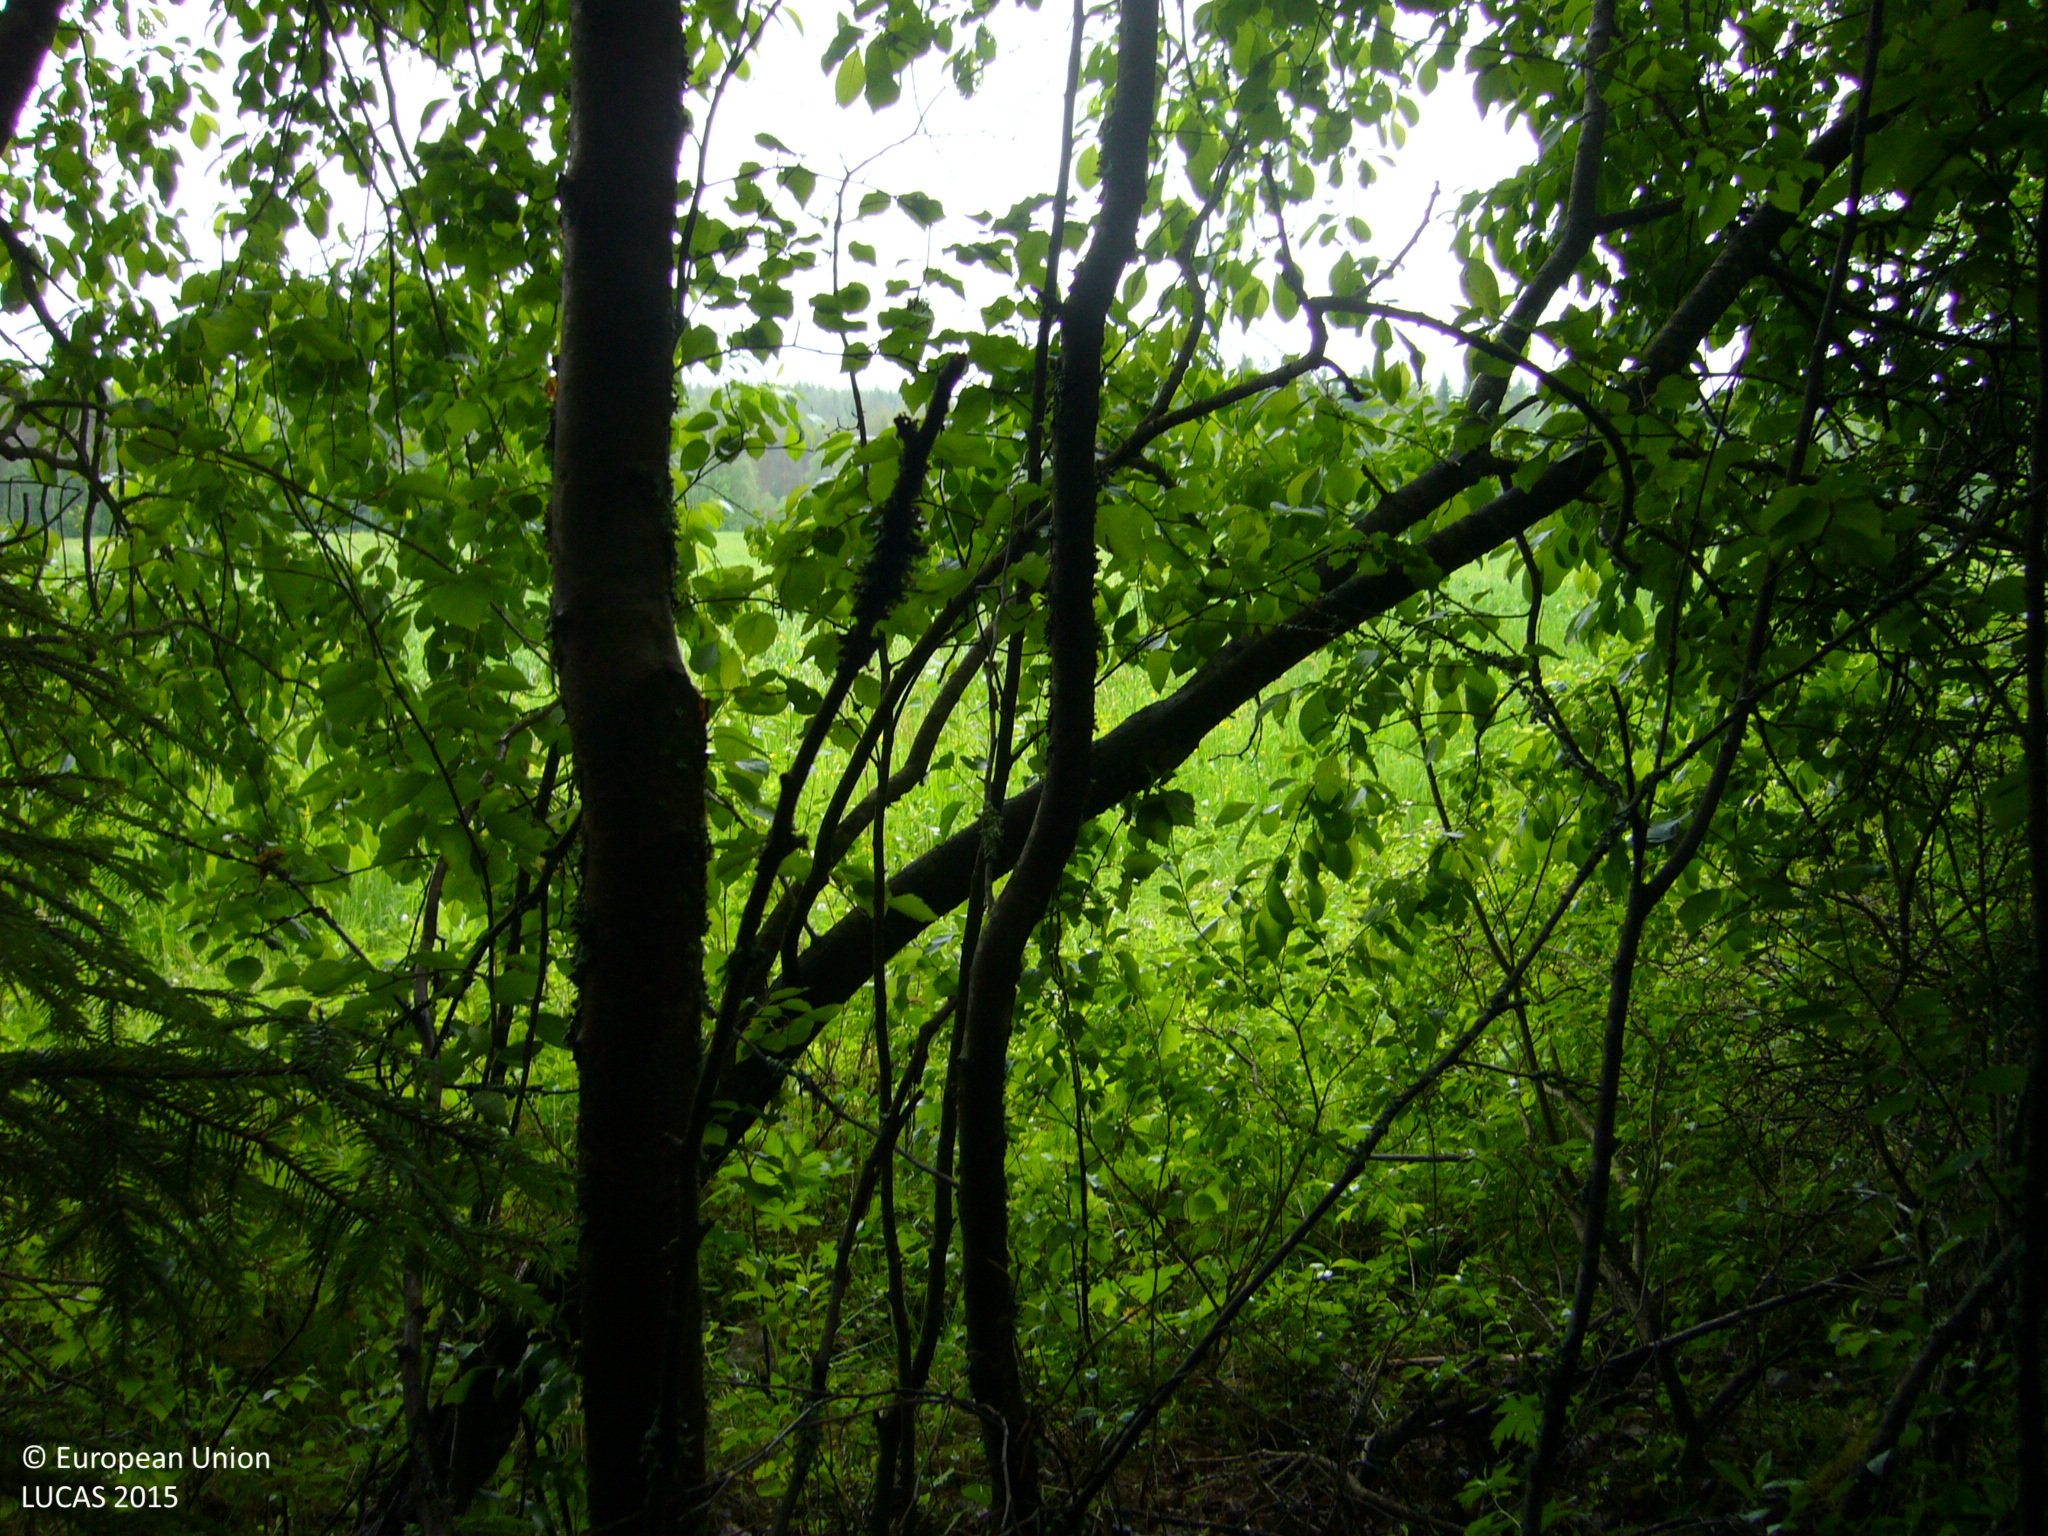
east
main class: Woodland
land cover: Other mixed woodland
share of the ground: > 75 %
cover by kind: broadleaved forest trees 55 %, coniferous forest trees 45 %
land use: Forestry
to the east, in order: Other mixed woodland; Temporary grasslands; Broadleaved woodland; Ditches and canals; Temporary grasslands; Ditches and canals; Other bare soil
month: June
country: FI
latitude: 63.5929
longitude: 26.3862
